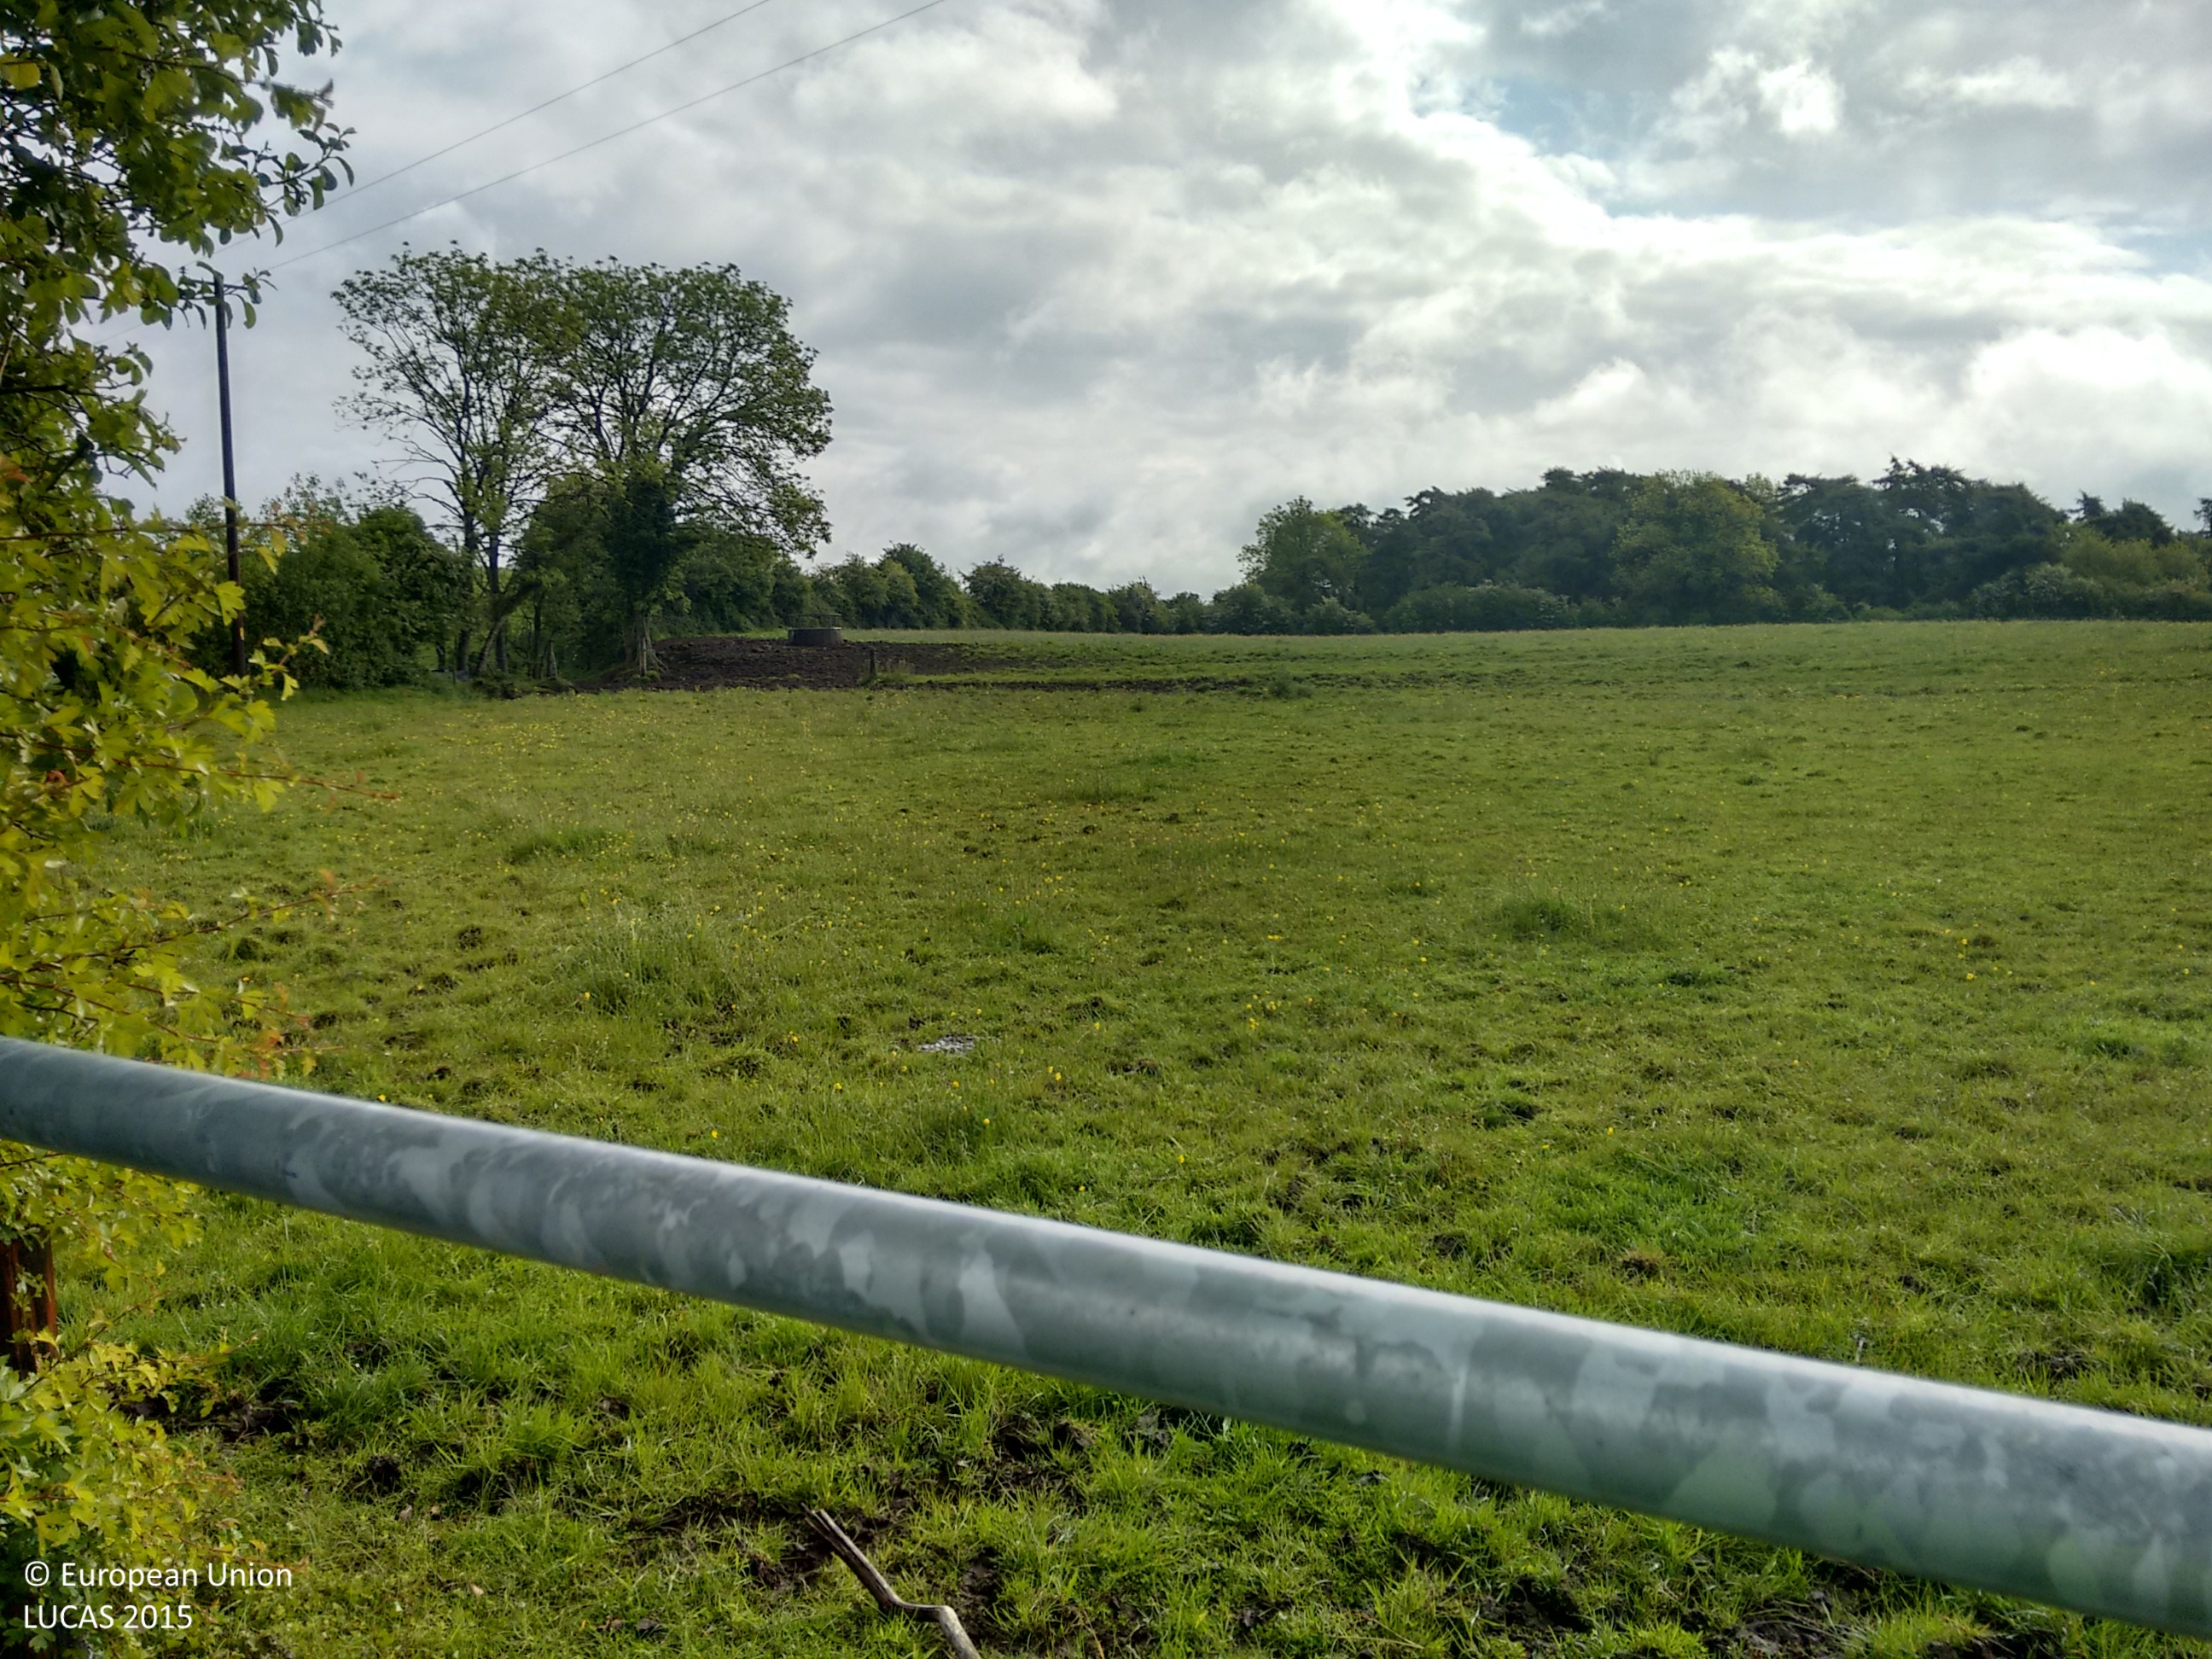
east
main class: Grassland
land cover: Grassland without tree/shrub cover
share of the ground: > 75 %
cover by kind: herbaceous plants 100 %
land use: Agriculture (excluding fallow land and kitchen gardens)
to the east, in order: Grassland without tree/shrub cover; Broadleaved woodland; Managed hedges; Grassland without tree/shrub cover; Managed hedges; Broadleaved woodland
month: June
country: IE
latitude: 53.3961
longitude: -6.9073
